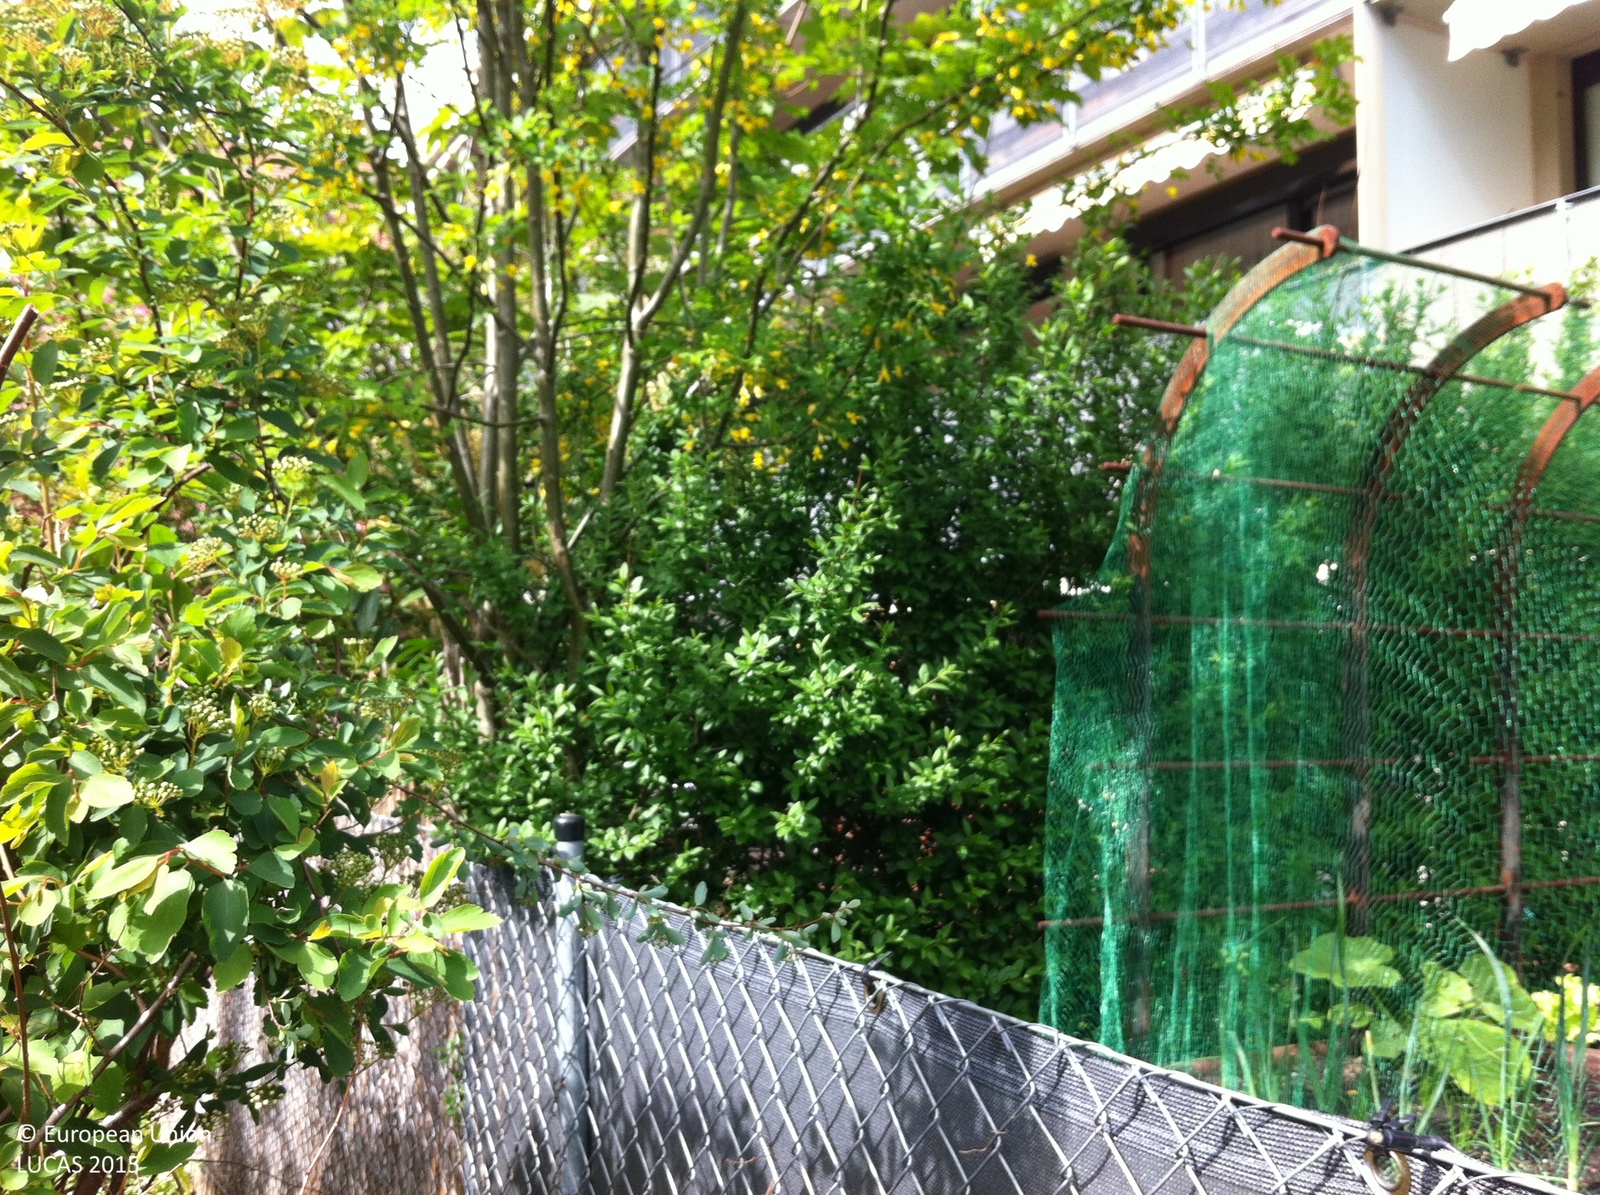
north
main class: Grassland
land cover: Grassland without tree/shrub cover
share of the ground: > 75 %
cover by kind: herbaceous plants 100 %
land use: Residential
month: May
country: AT
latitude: 47.2604
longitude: 11.4128
